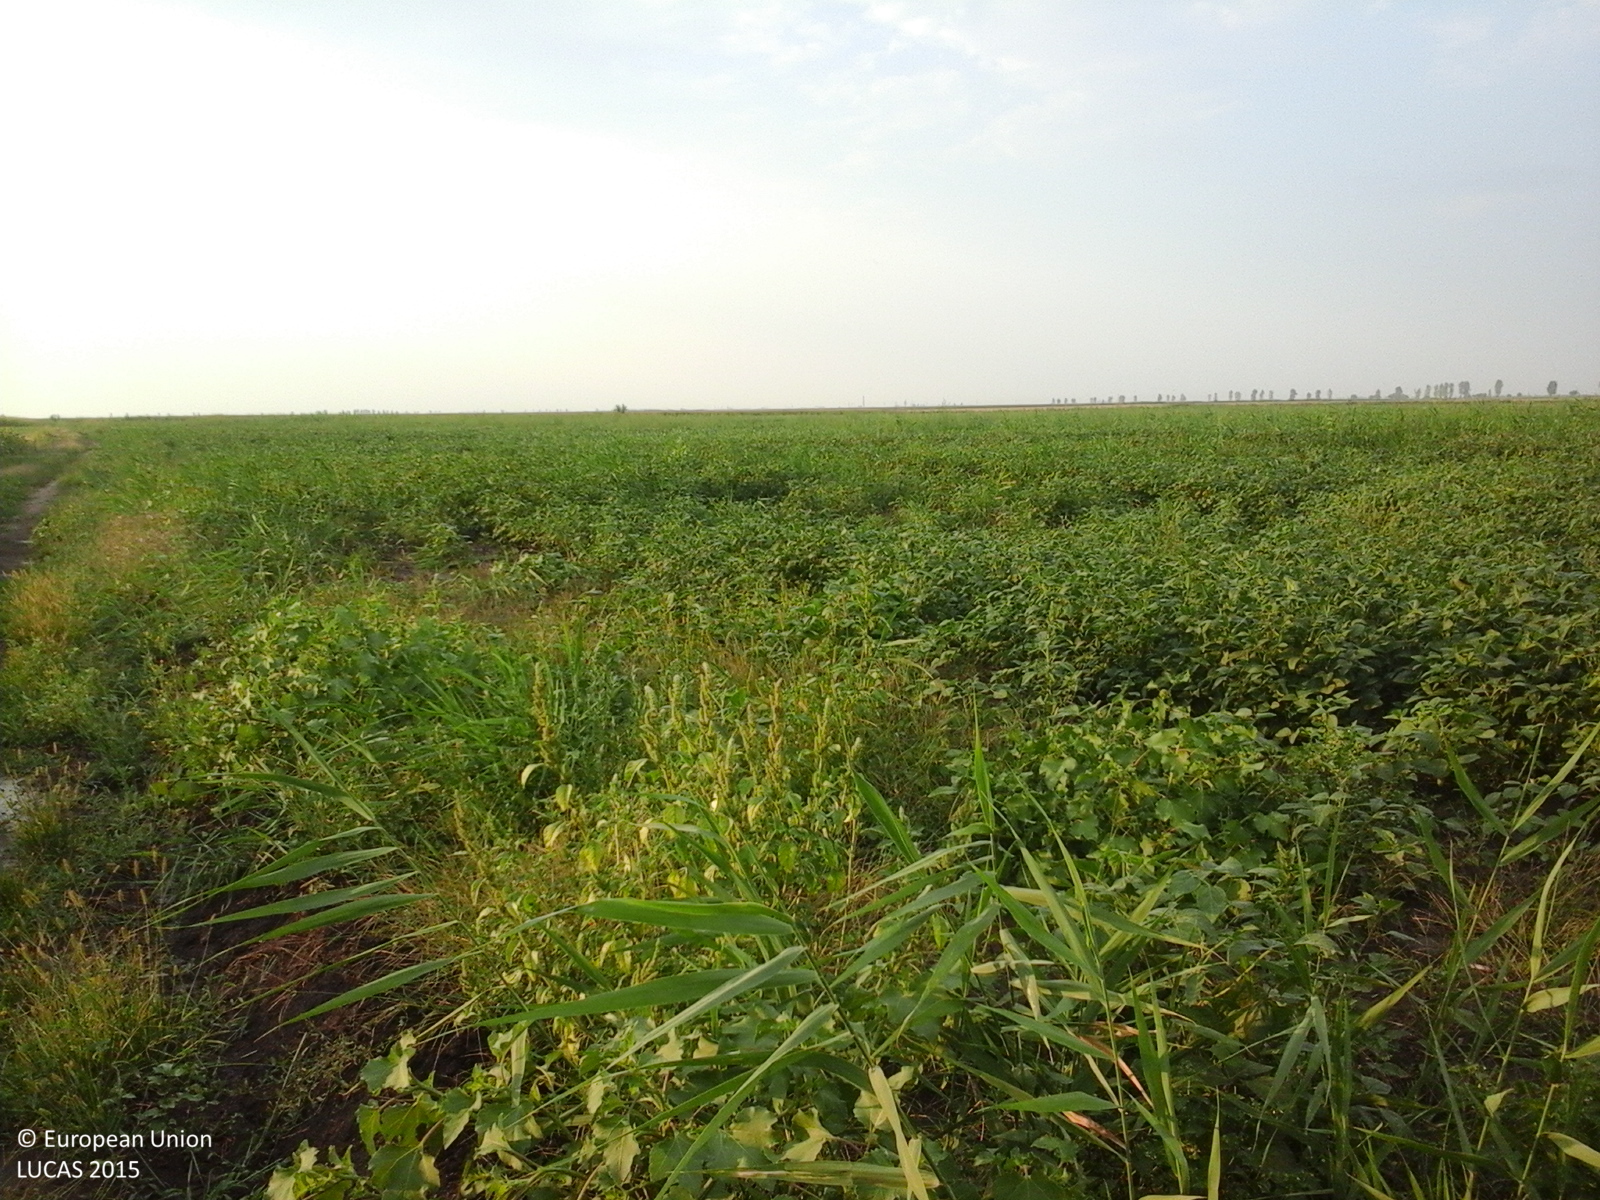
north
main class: Cropland
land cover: Soya
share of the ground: > 75 %
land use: Agriculture (excluding fallow land and kitchen gardens)
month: August
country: RO
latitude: 45.0624
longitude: 27.4836
